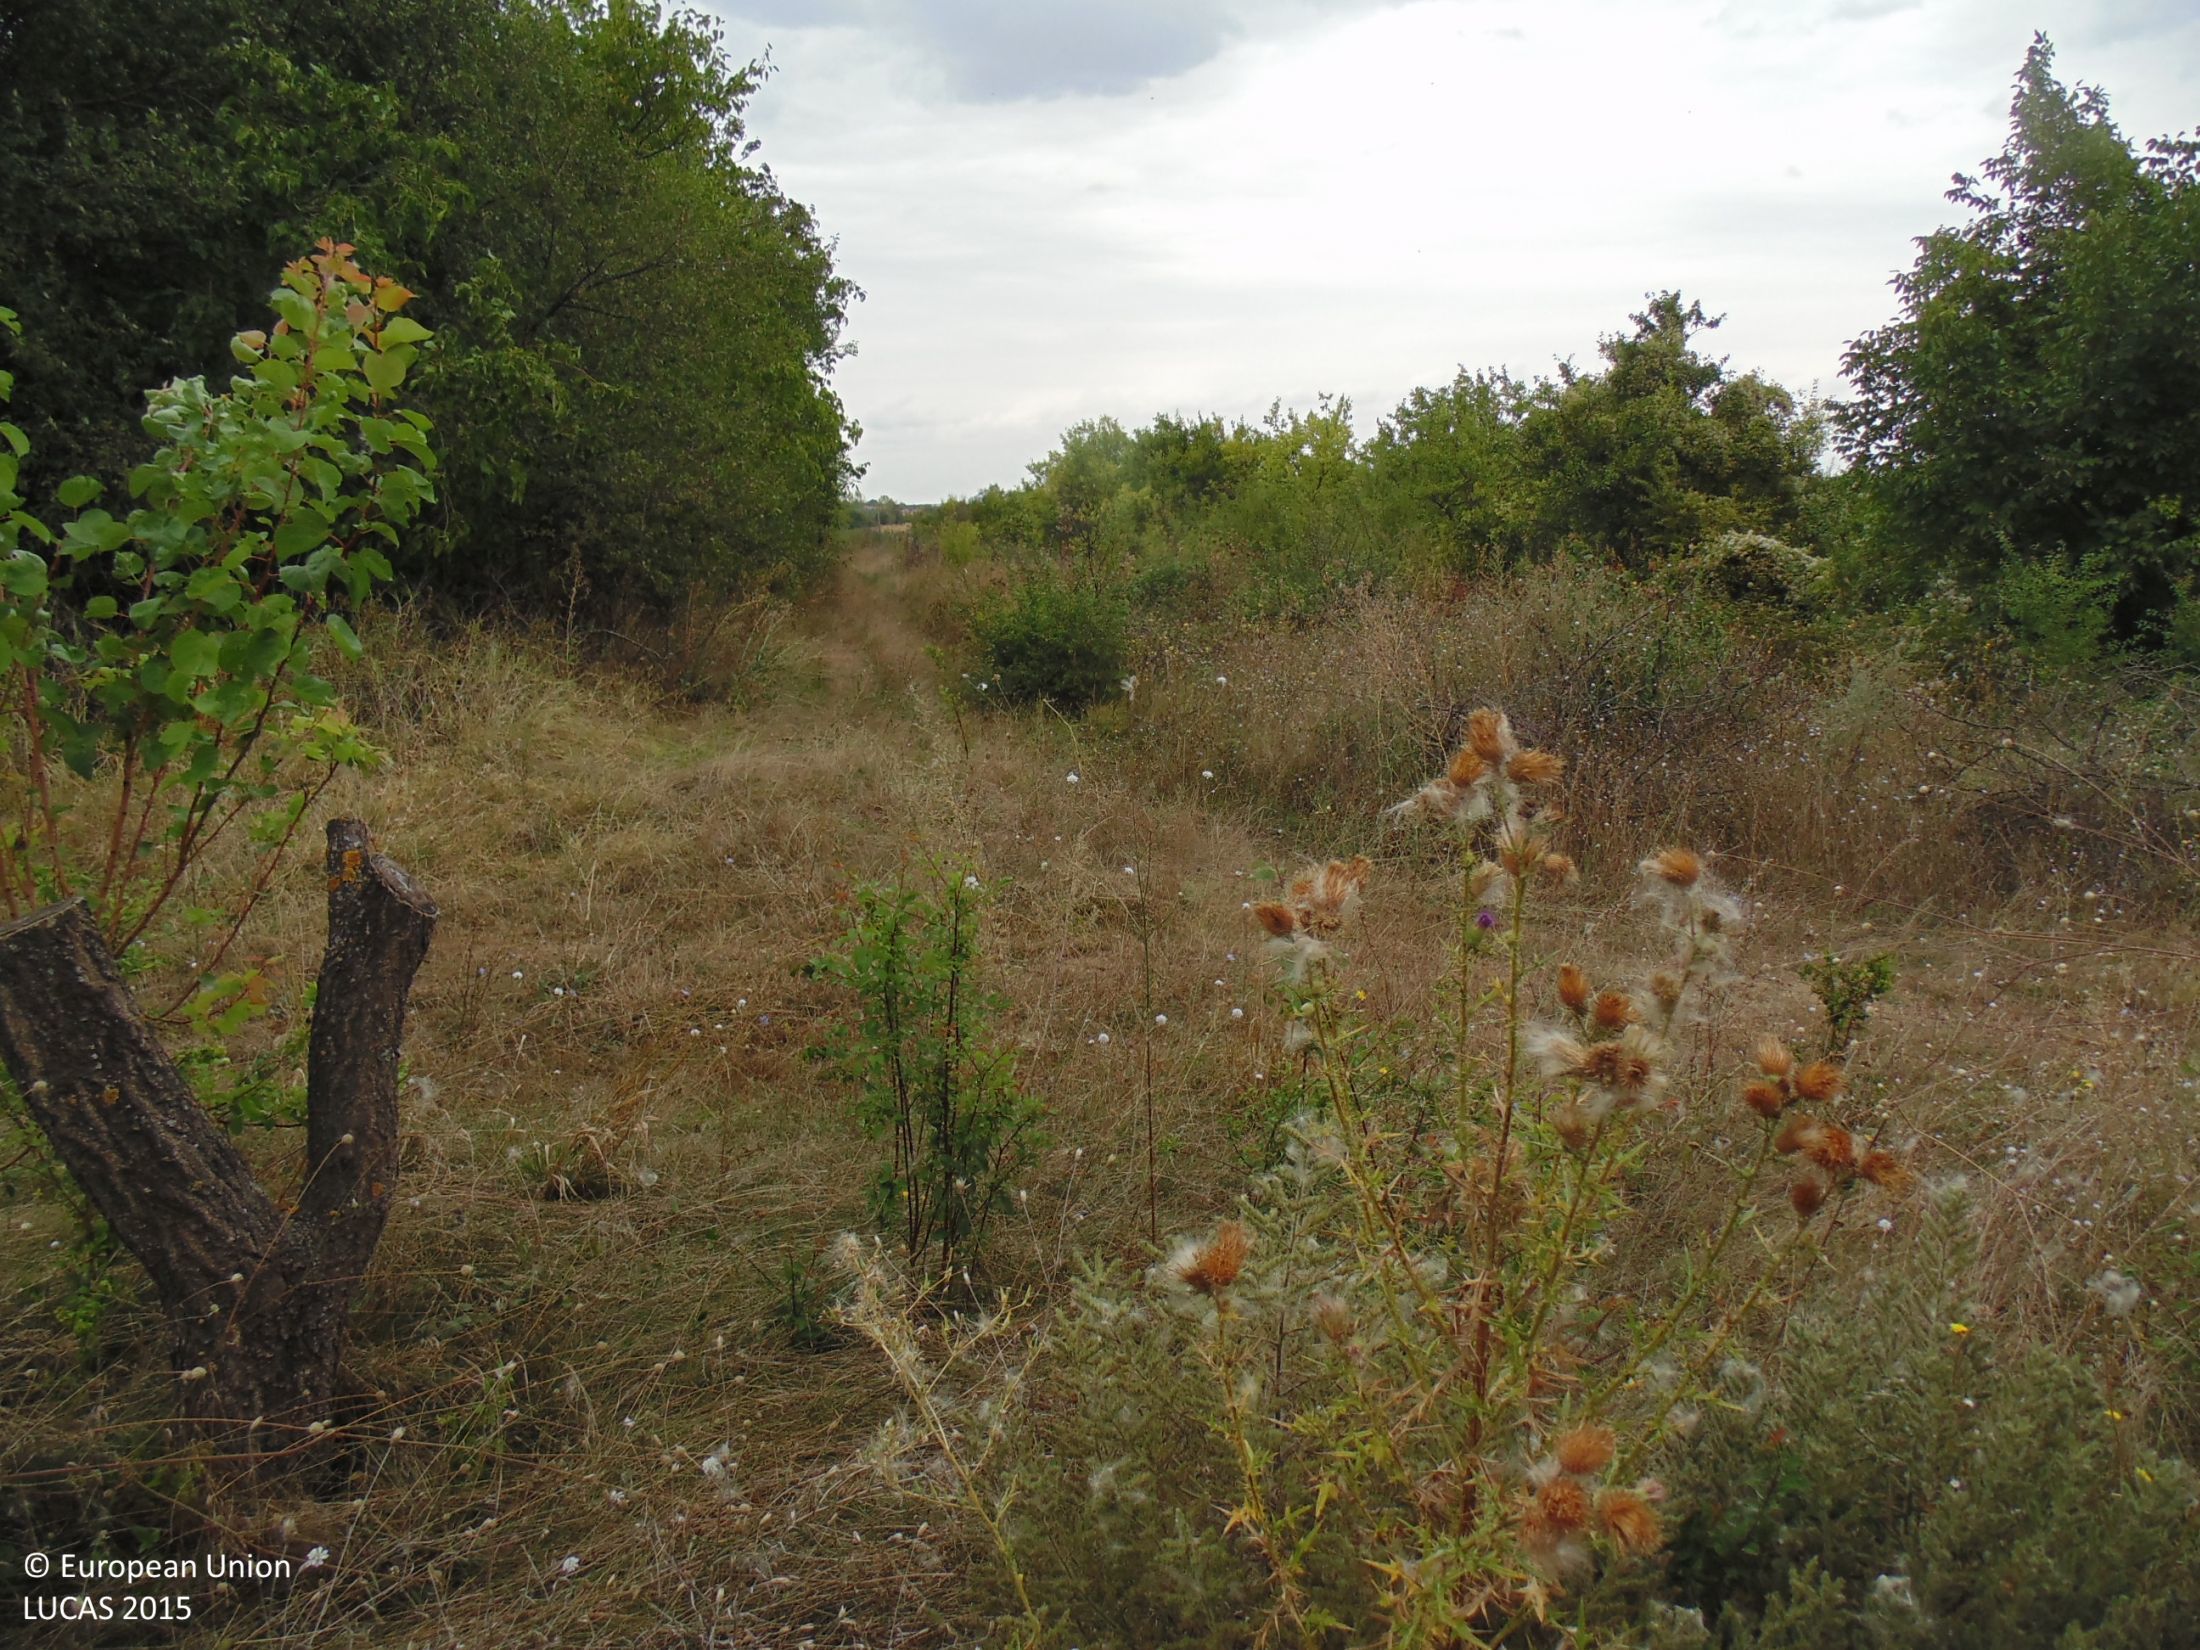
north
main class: Cropland
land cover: Other fruit trees and berries
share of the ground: 50 - 75 %
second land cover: Grassland without tree/shrub cover
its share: > 75 %
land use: Agriculture (excluding fallow land and kitchen gardens)
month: September
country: BG
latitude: 44.0164
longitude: 27.0269
